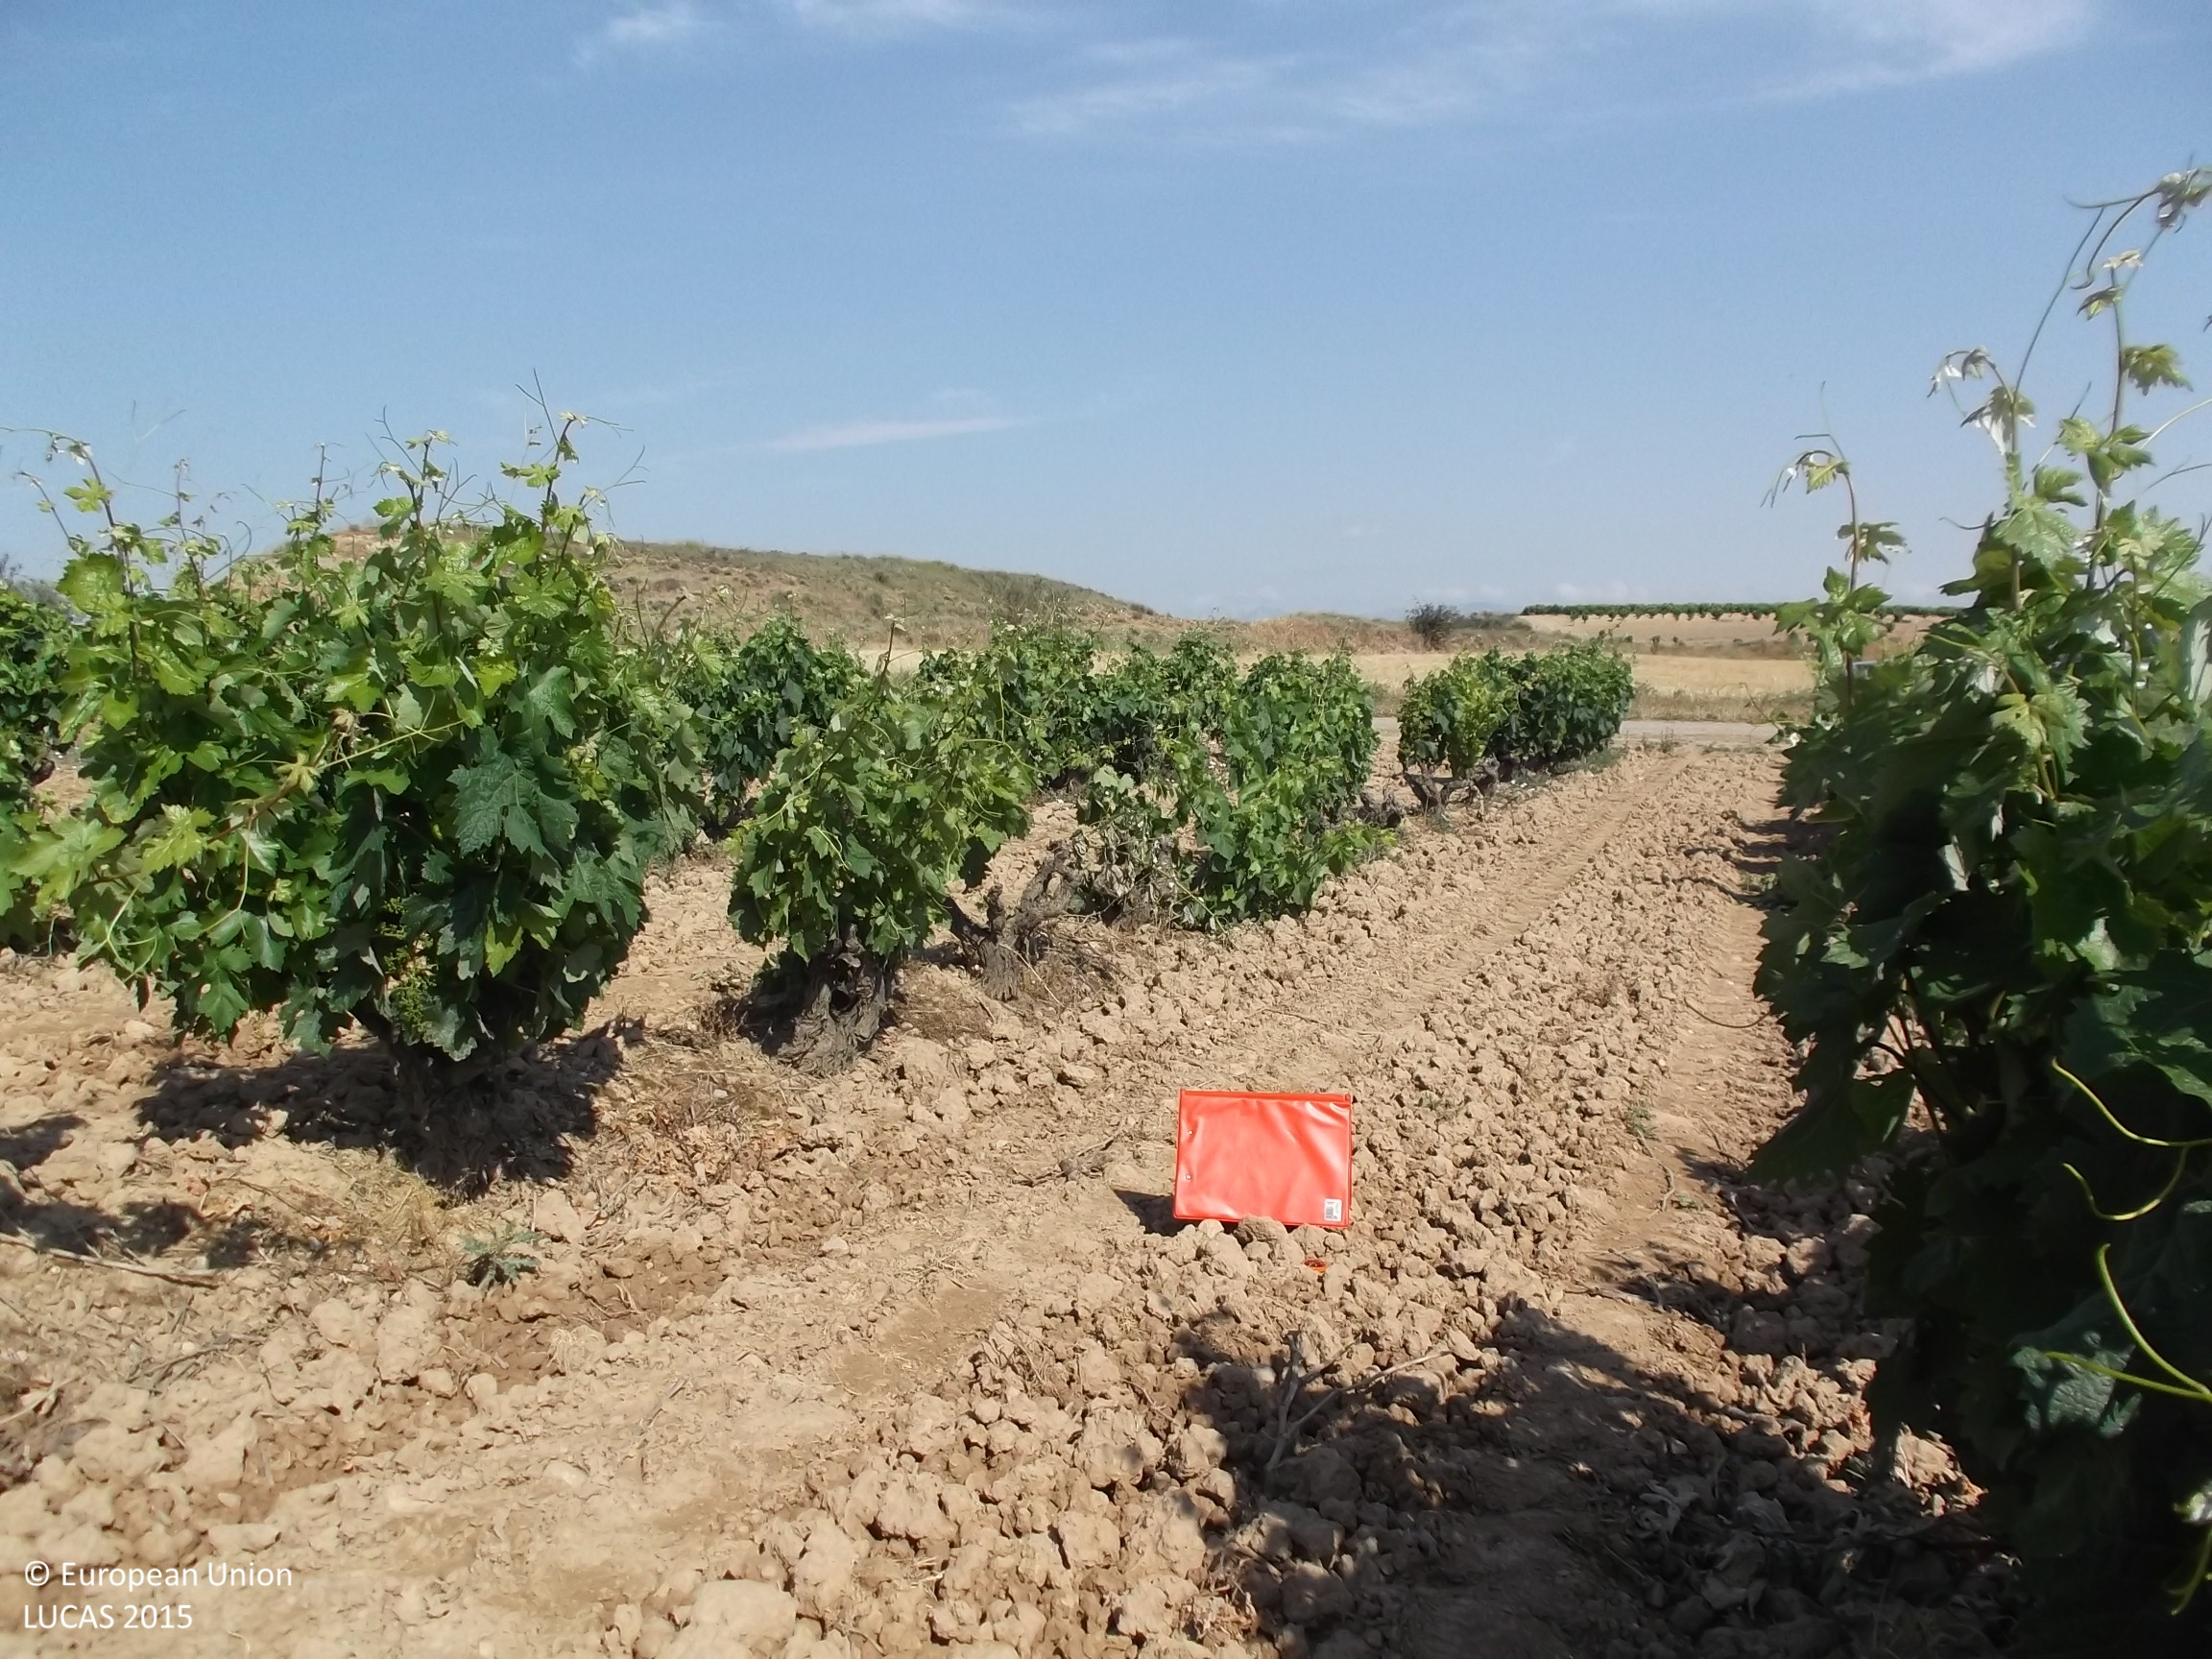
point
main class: Cropland
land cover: Vineyards
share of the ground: 25 - 50 %
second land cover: Other bare soil
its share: > 75 %
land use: Agriculture (excluding fallow land and kitchen gardens)
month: June
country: ES
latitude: 42.4918
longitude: -2.3939
